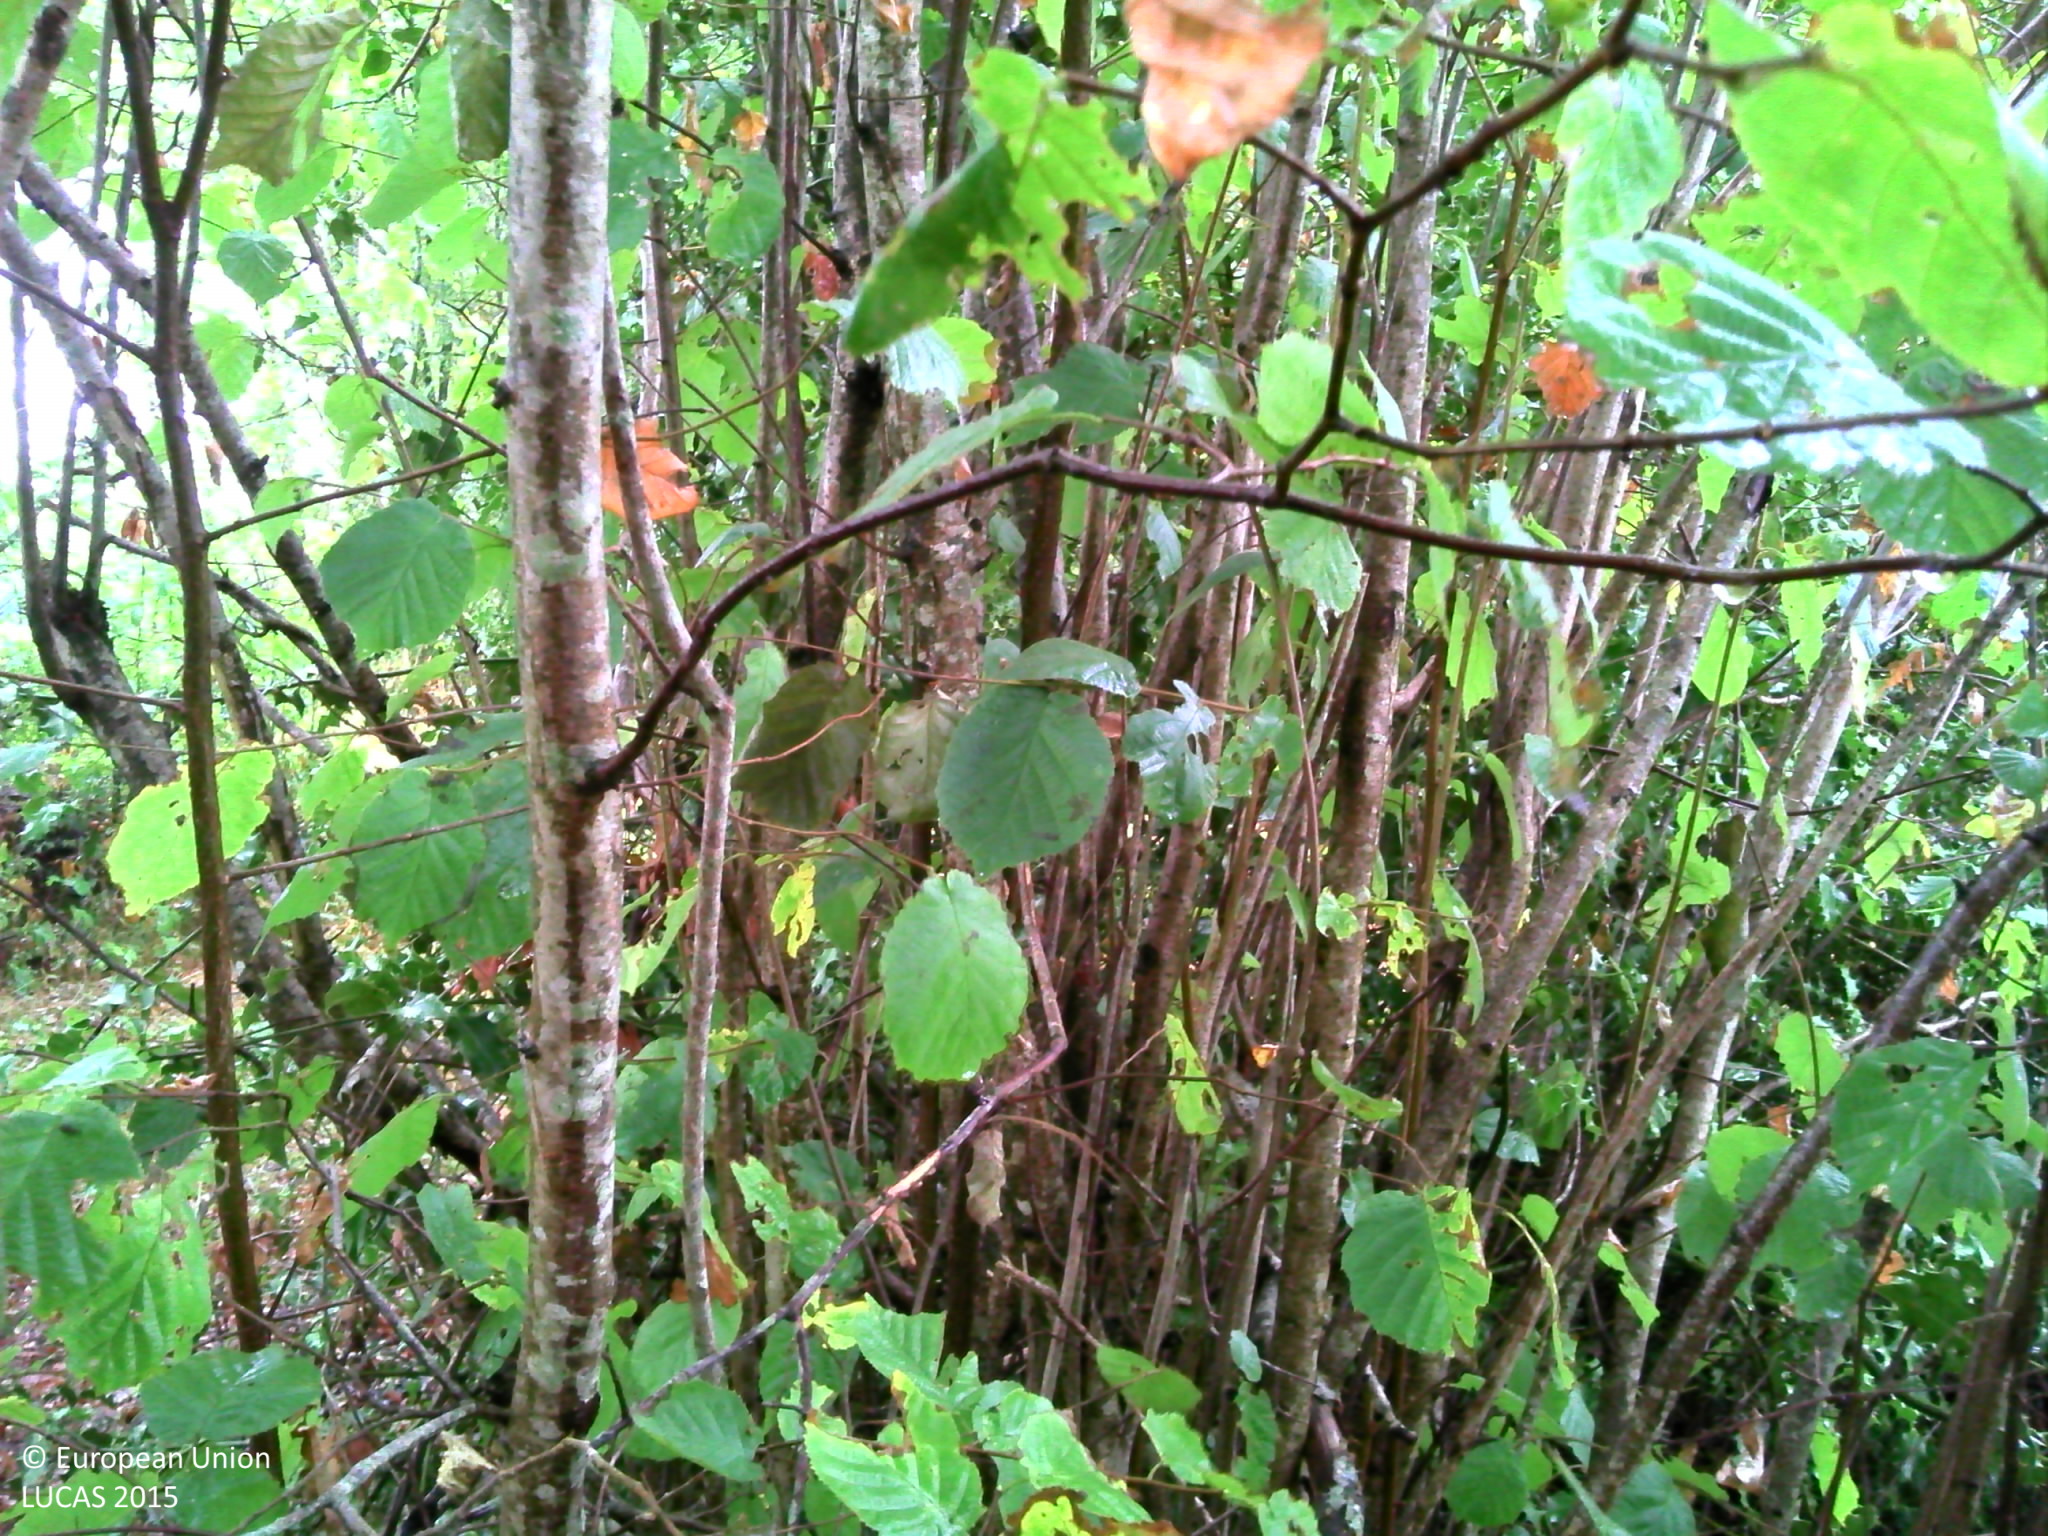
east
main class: Grassland
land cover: Grassland without tree/shrub cover
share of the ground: > 75 %
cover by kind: herbaceous plants 100 %
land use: Agriculture (excluding fallow land and kitchen gardens)
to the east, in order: Managed hedges; Tracks; Managed hedges; Grassland without tree/shrub cover; Abandoned hedges; Grassland without tree/shrub cover
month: August
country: FR
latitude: 47.6127
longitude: 3.1432
